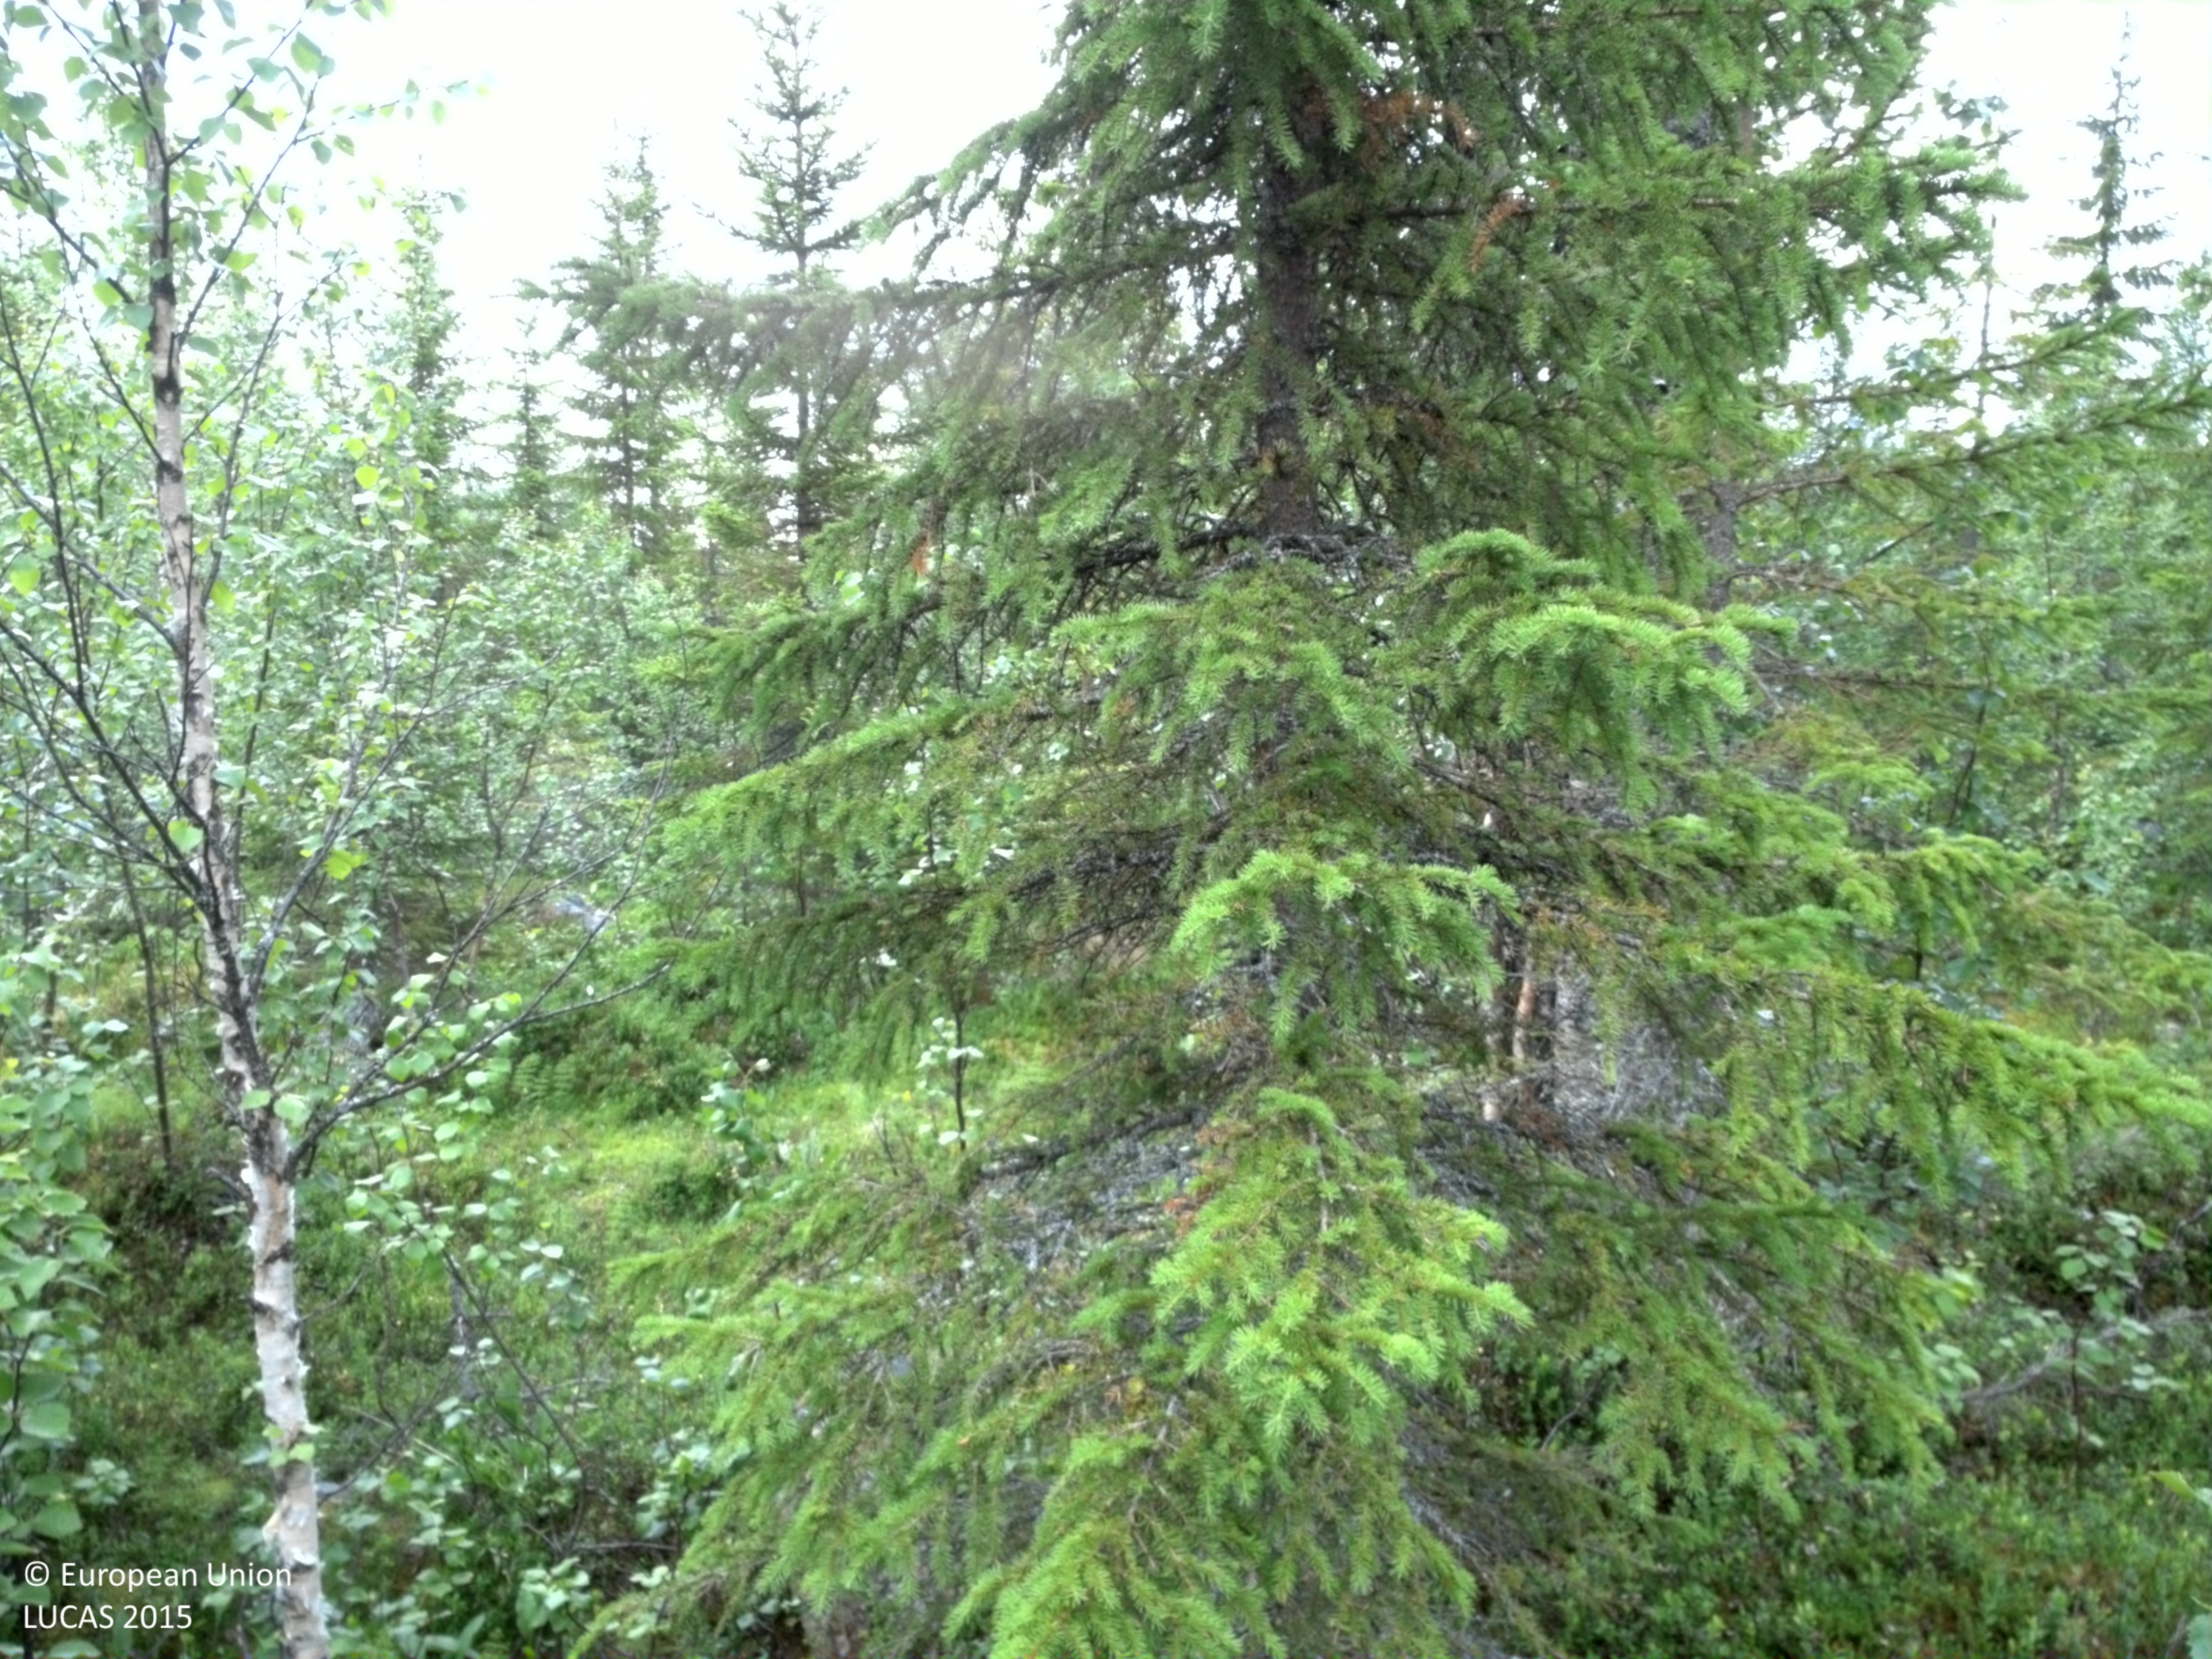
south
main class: Woodland
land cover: Spruce dominated mixed woodland
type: boreal forest
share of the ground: 25 - 50 %
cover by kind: shrubs 40 %, broadleaved forest trees 25 %, coniferous forest trees 15 %, lichens and mosses 15 %, herbaceous plants 5 %
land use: Forestry
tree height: > 5 m
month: August
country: SE
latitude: 64.8377
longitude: 16.2267
